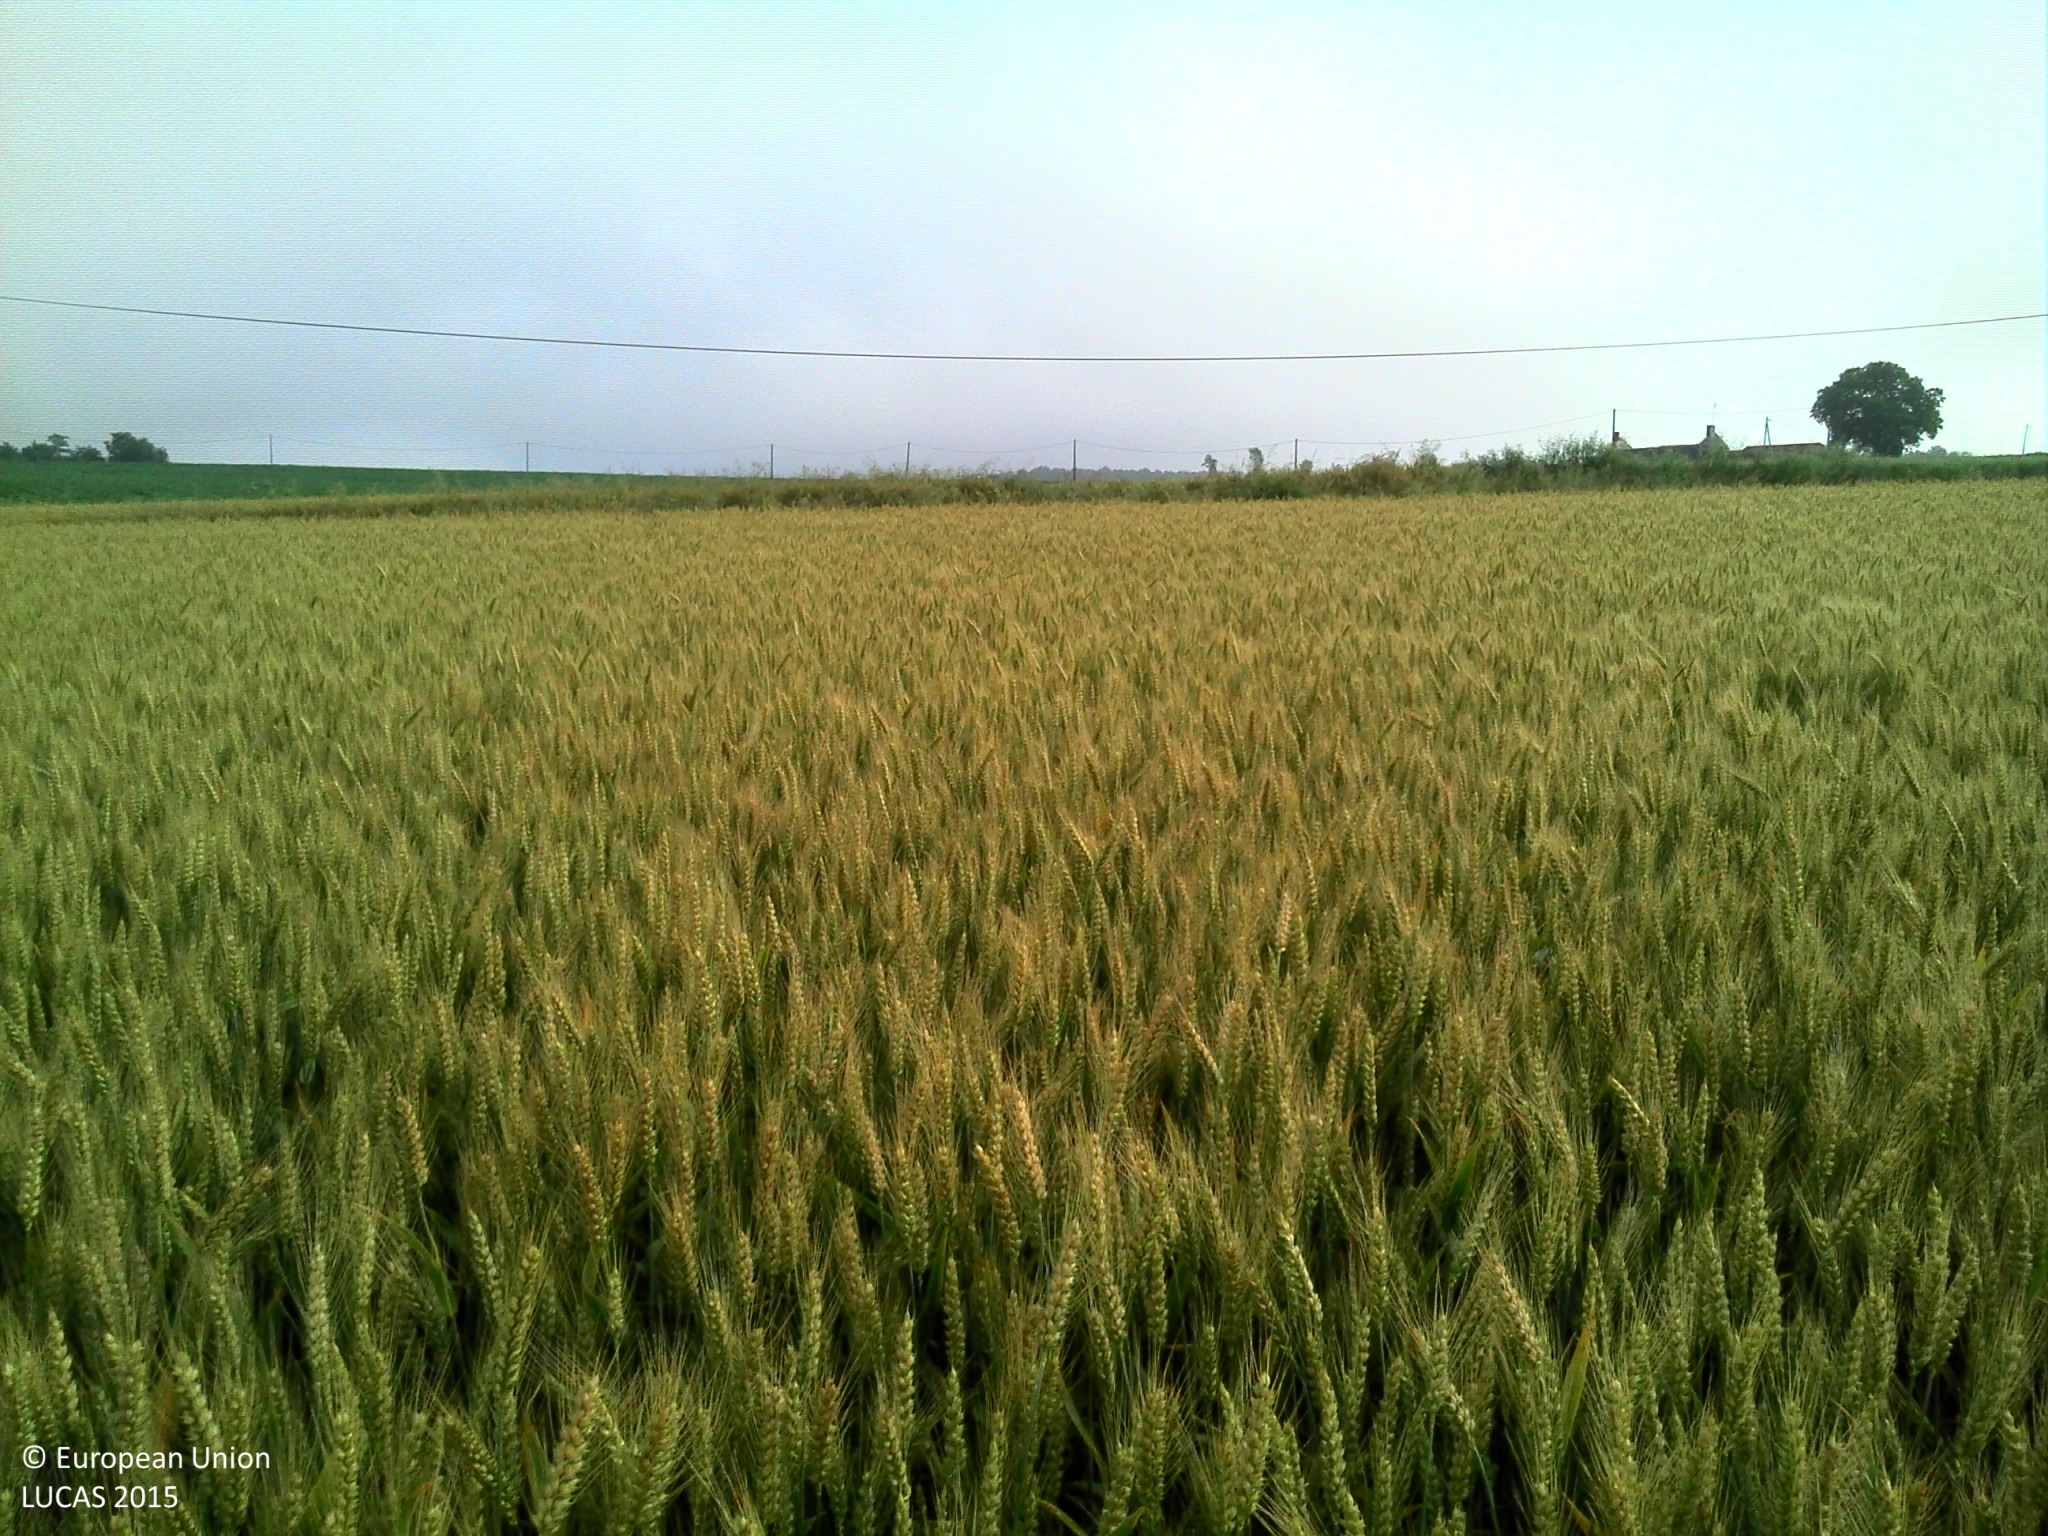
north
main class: Cropland
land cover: Common wheat
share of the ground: > 75 %
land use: Agriculture (excluding fallow land and kitchen gardens)
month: June
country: FR
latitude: 46.8853
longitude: 0.4664
